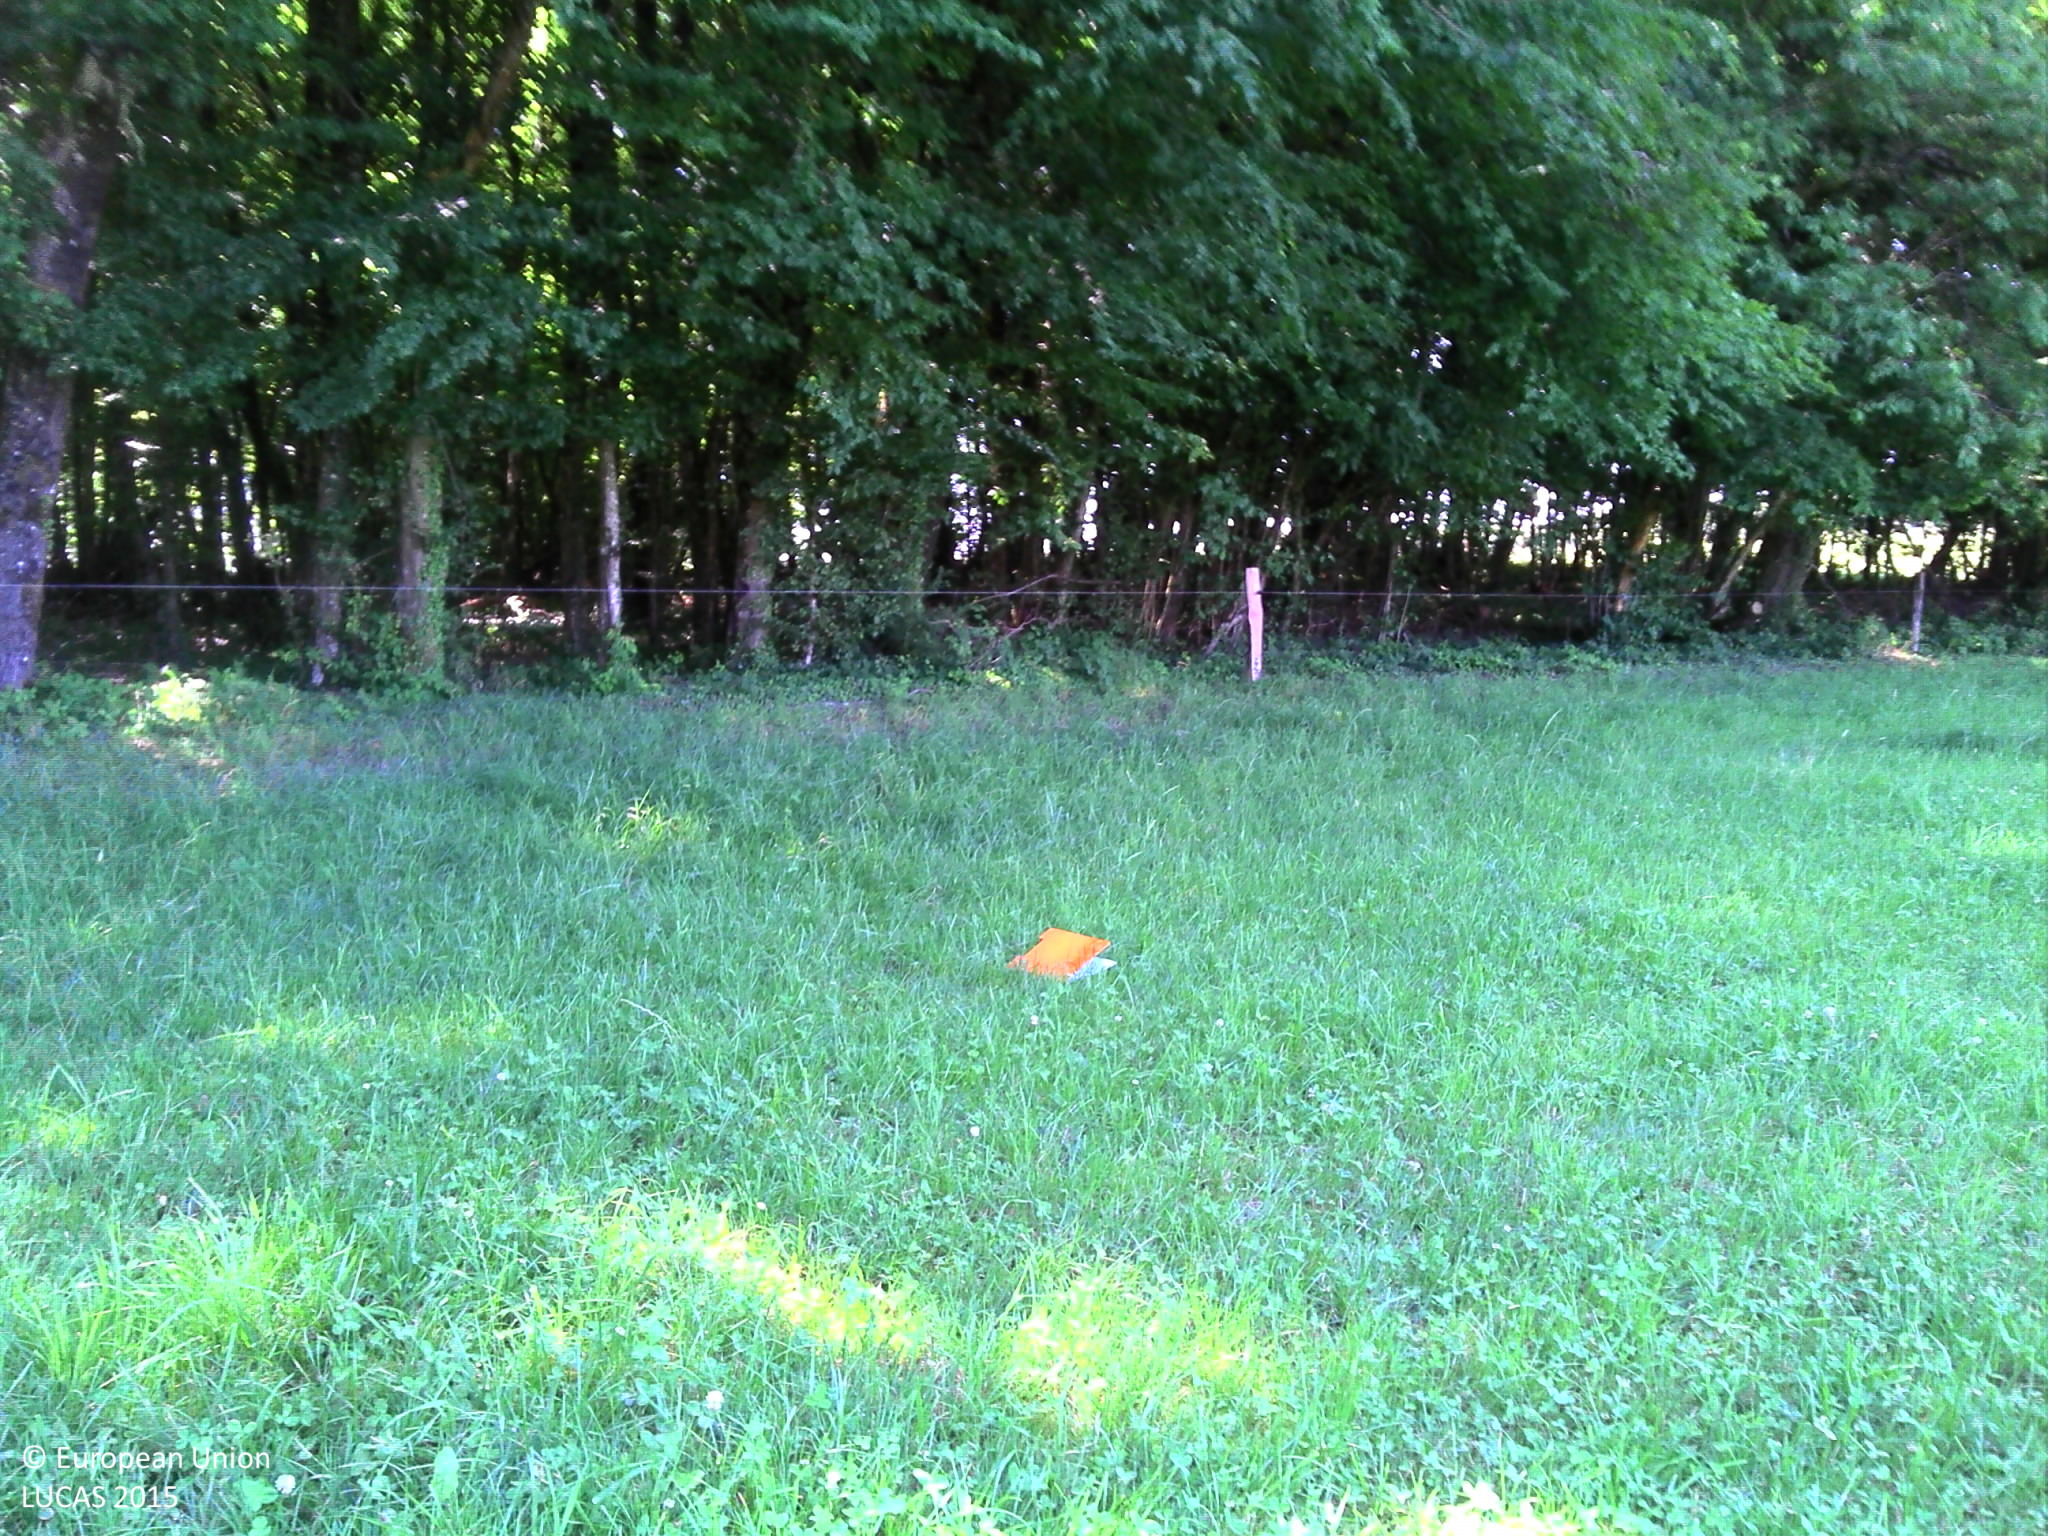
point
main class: Cropland
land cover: Temporary grasslands
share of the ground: > 75 %
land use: Agriculture (excluding fallow land and kitchen gardens)
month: June
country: FR
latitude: 47.4534
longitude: 6.1418
